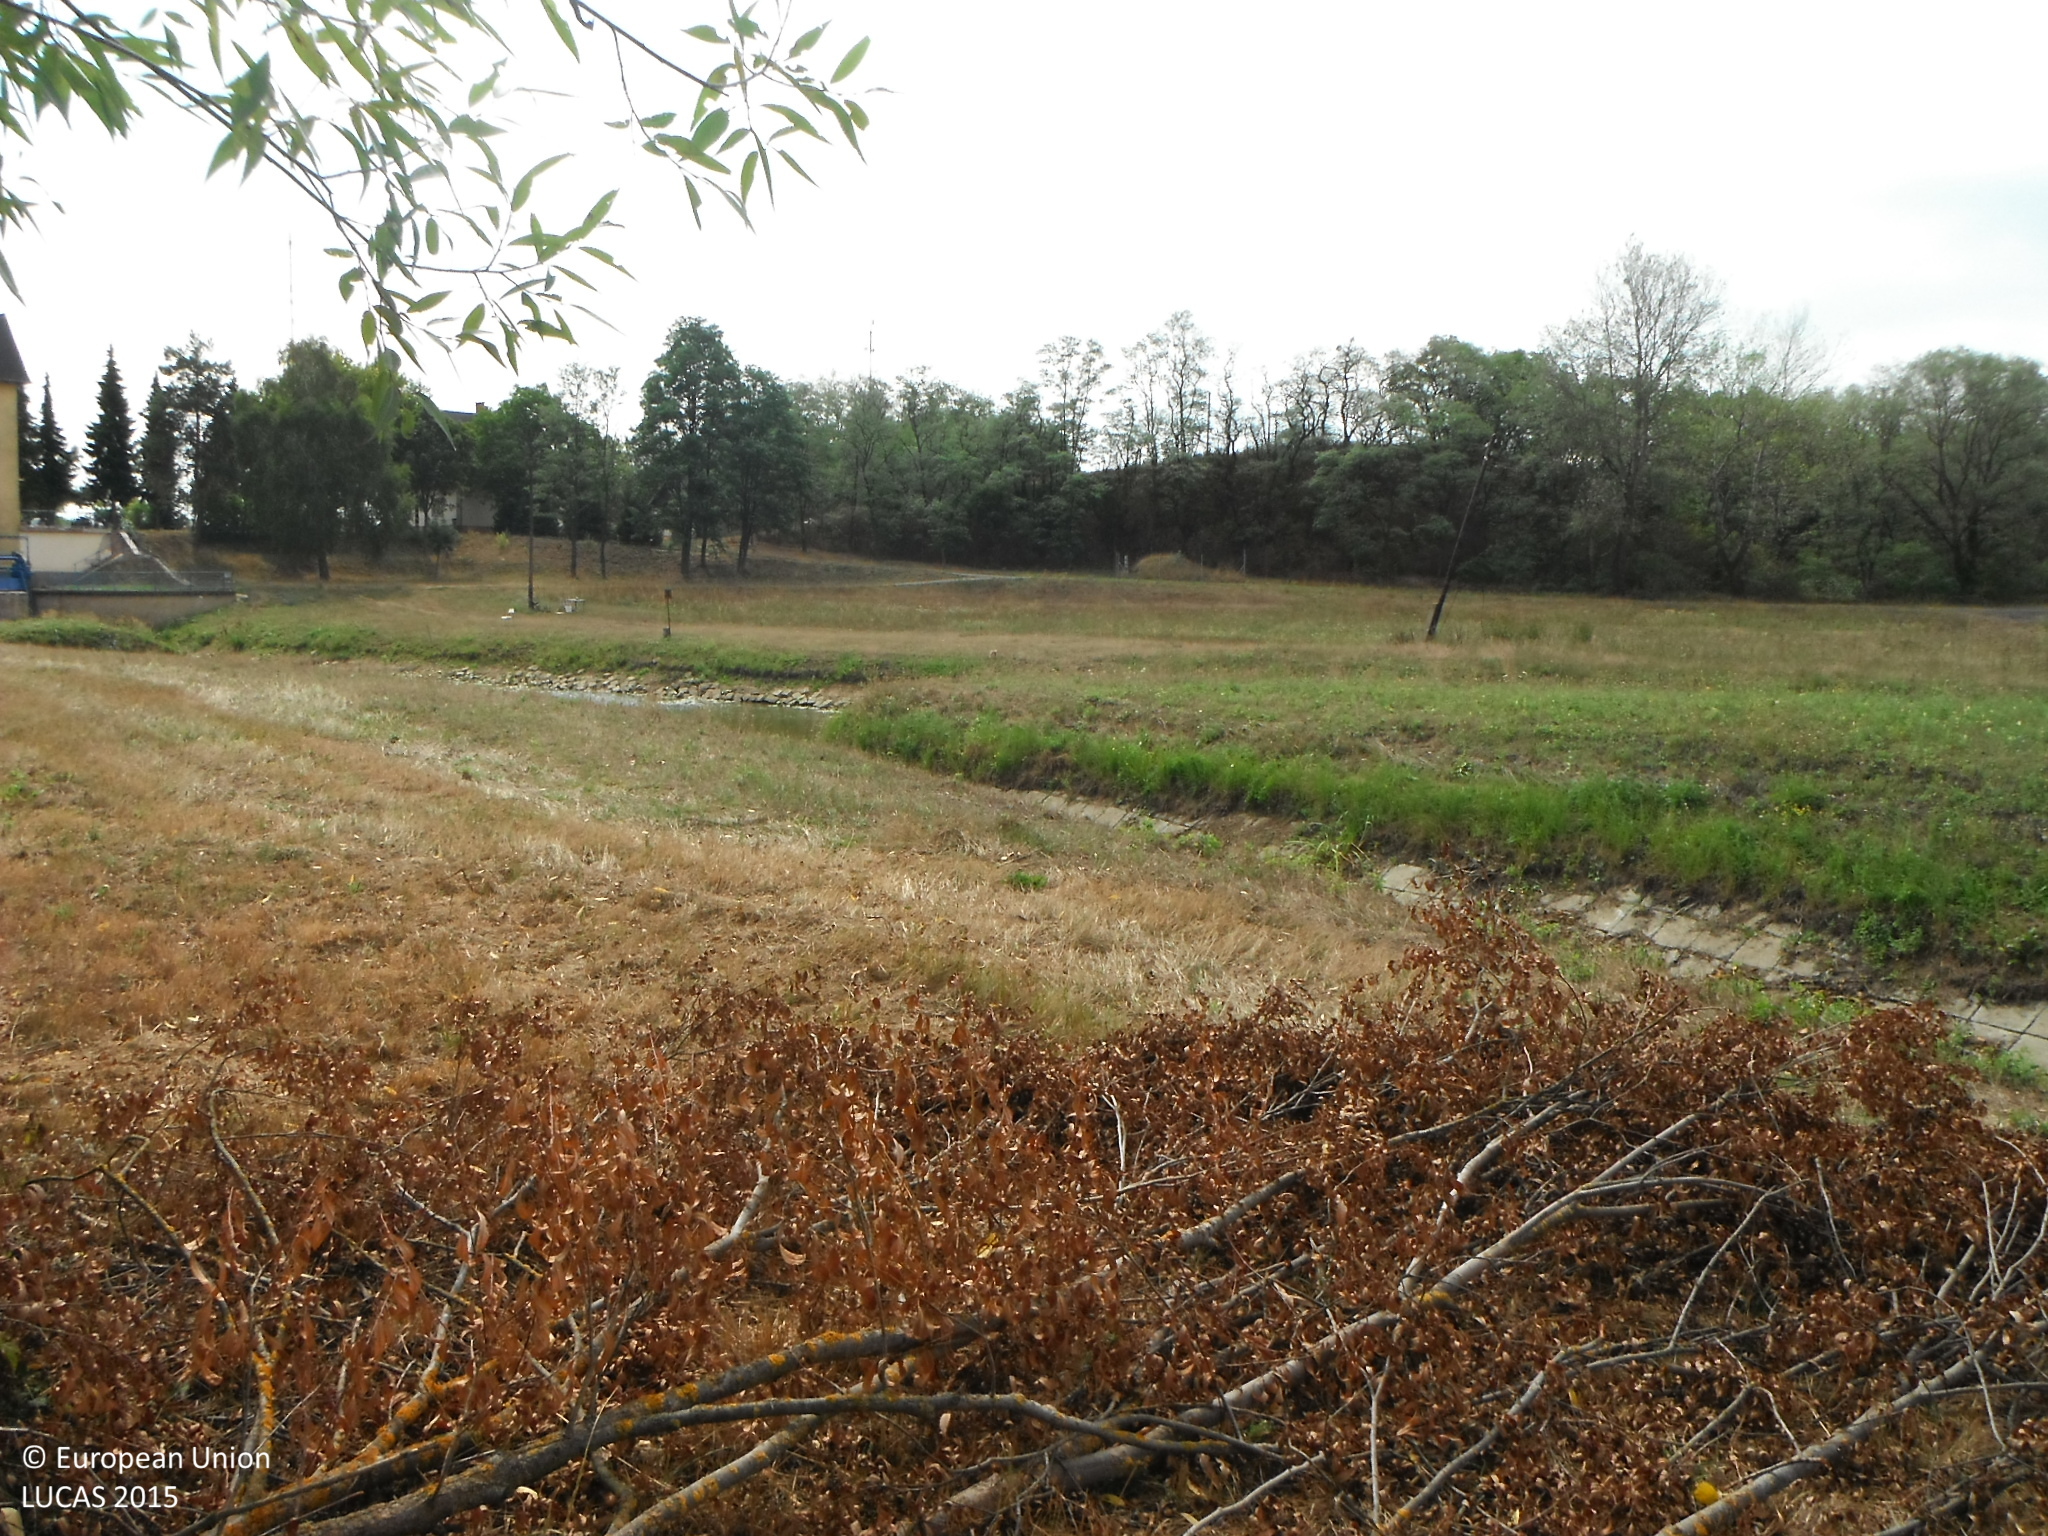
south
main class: Grassland
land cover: Grassland with sparse tree/shrub cover
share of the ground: > 75 %
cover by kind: herbaceous plants 90 %, broadleaved forest trees 5 %, shrubs 5 %
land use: Agriculture (excluding fallow land and kitchen gardens)
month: August
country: SK
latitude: 48.4924
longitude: 21.8378
